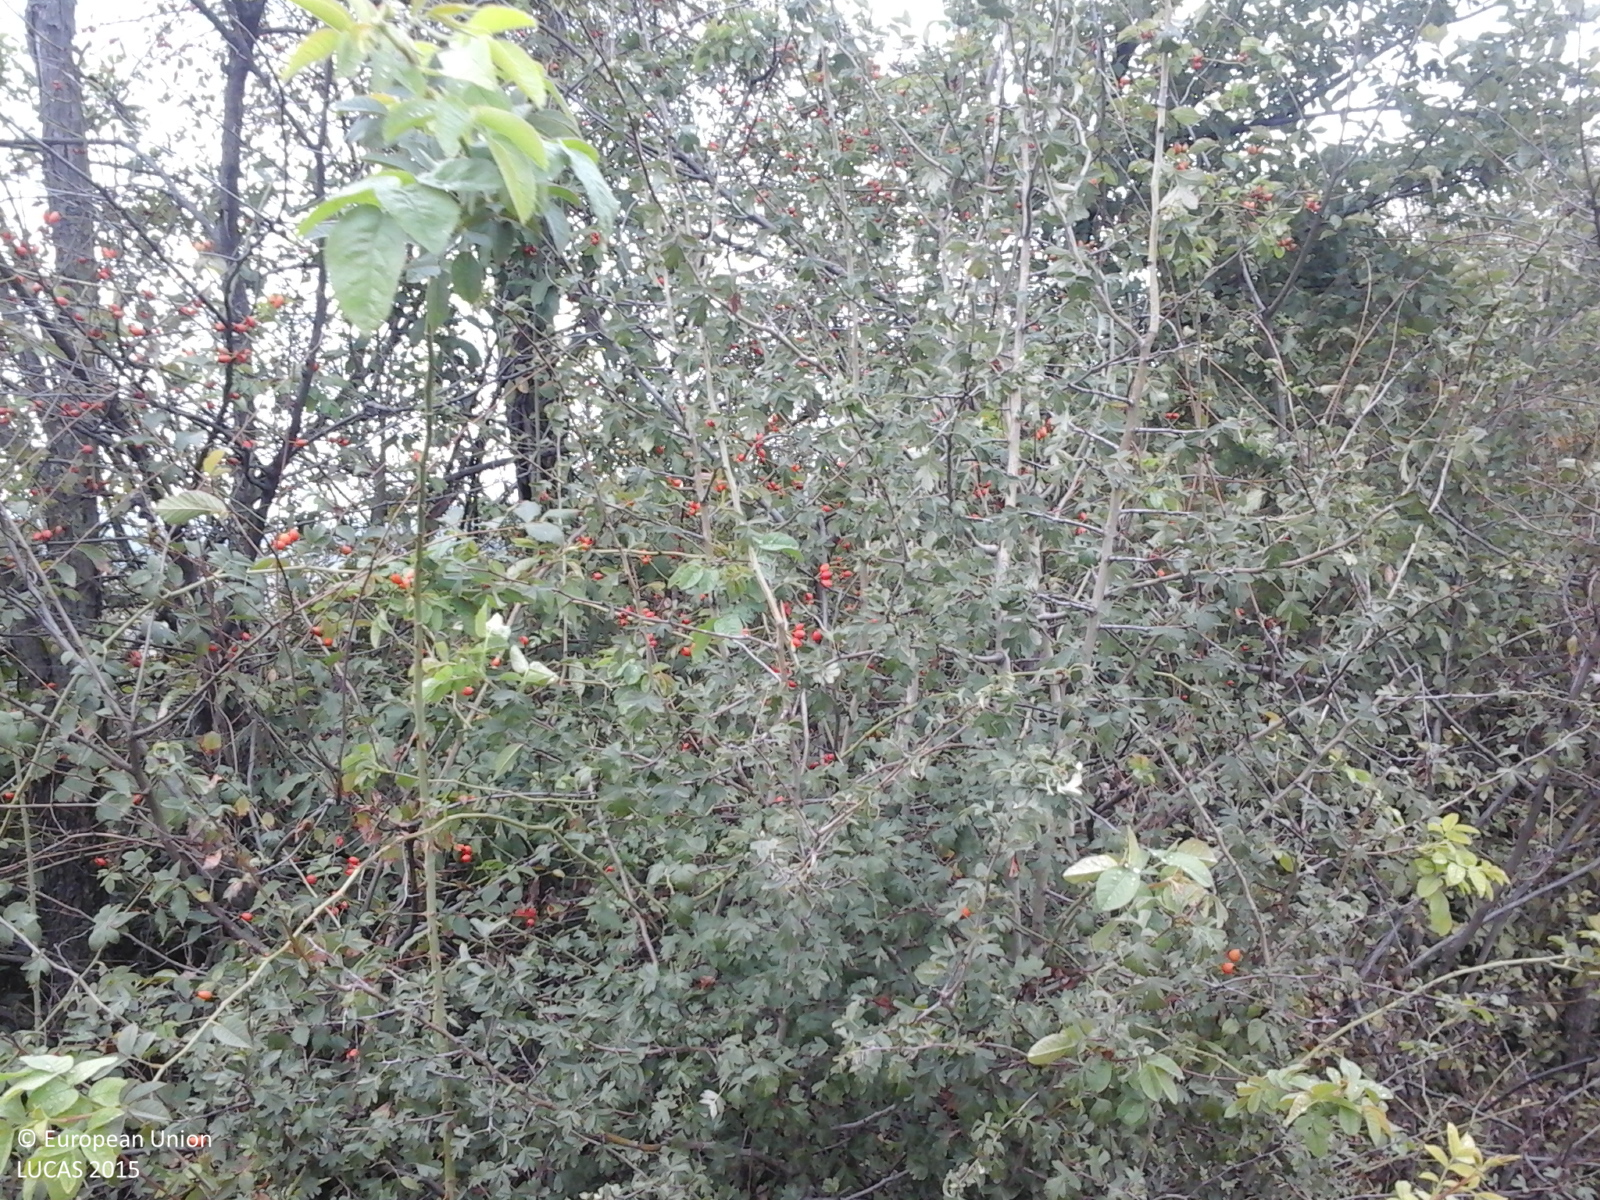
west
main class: Grassland
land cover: Grassland without tree/shrub cover
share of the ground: > 75 %
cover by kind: herbaceous plants 100 %
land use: Agriculture (excluding fallow land and kitchen gardens)
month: September
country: RO
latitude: 47.2671
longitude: 22.3855
